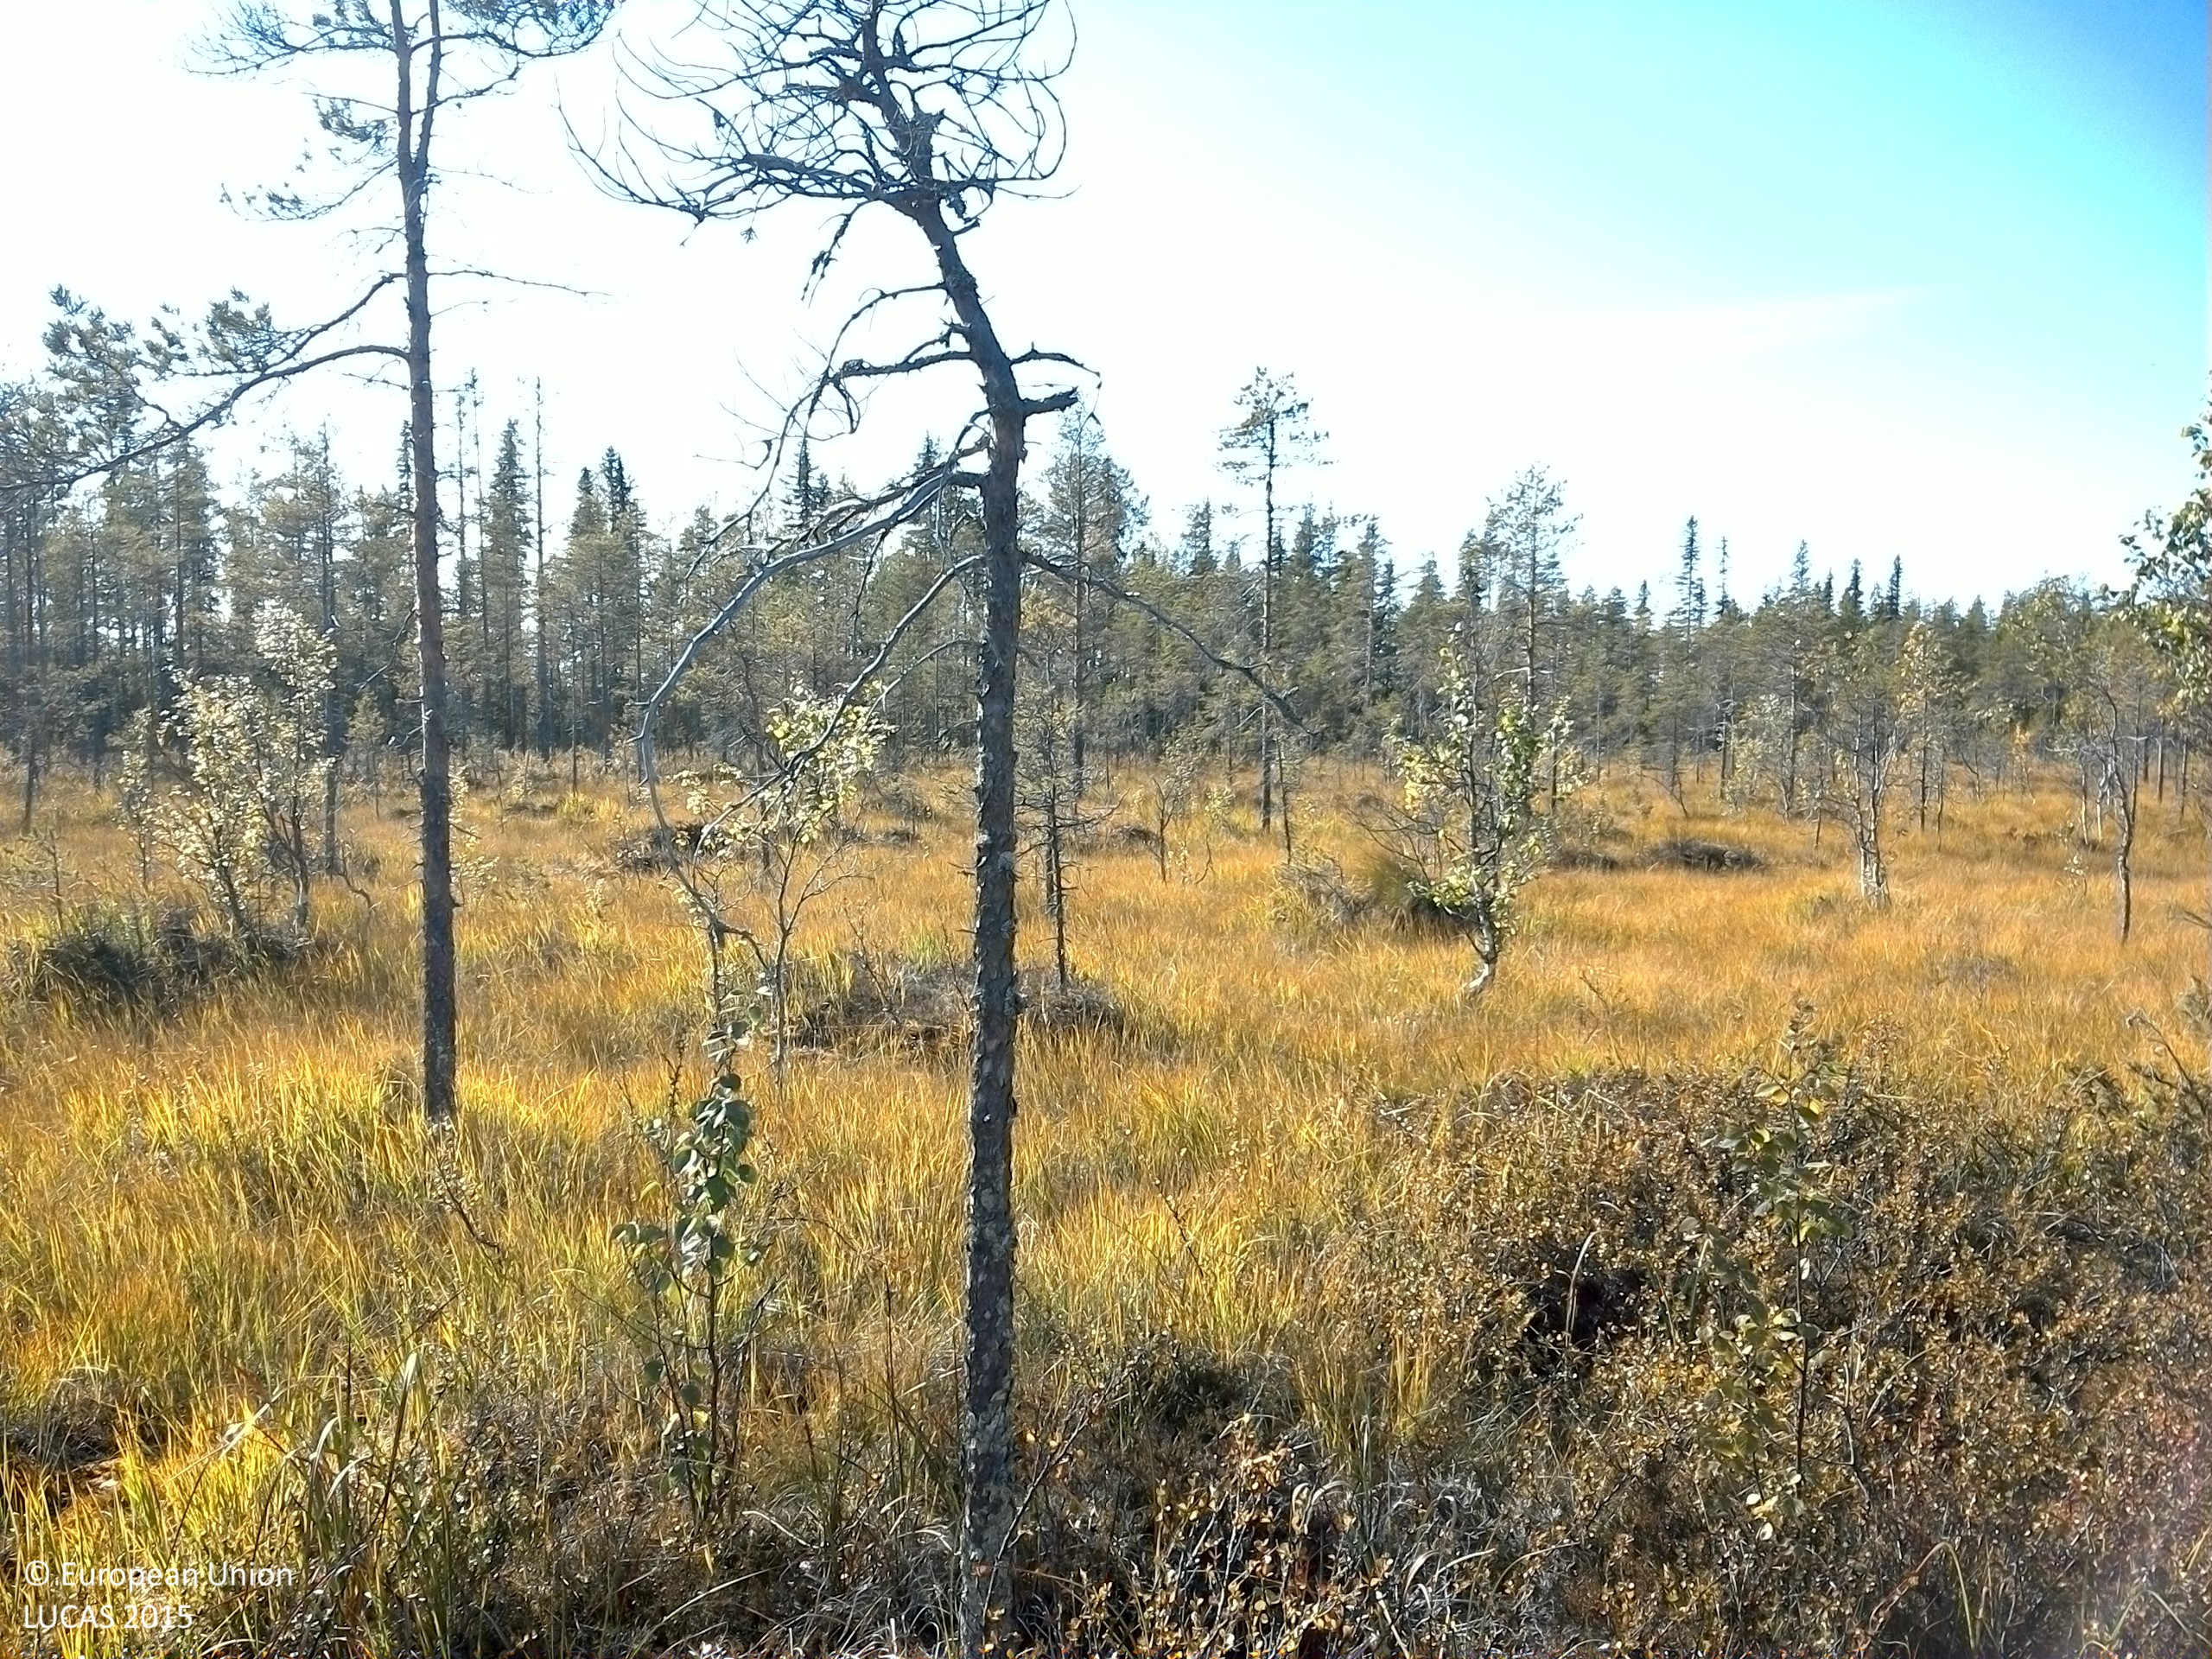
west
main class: Woodland
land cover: Pine dominated mixed woodland
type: mire and swamp forests
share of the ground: 10 - 25 %
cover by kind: herbaceous plants 45 %, shrubs 20 %, lichens and mosses 15 %, coniferous forest trees 10 %, broadleaved forest trees 10 %
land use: Semi-natural and natural areas not in use
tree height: < 5 m
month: September
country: SE
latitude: 63.8021
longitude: 16.7326
